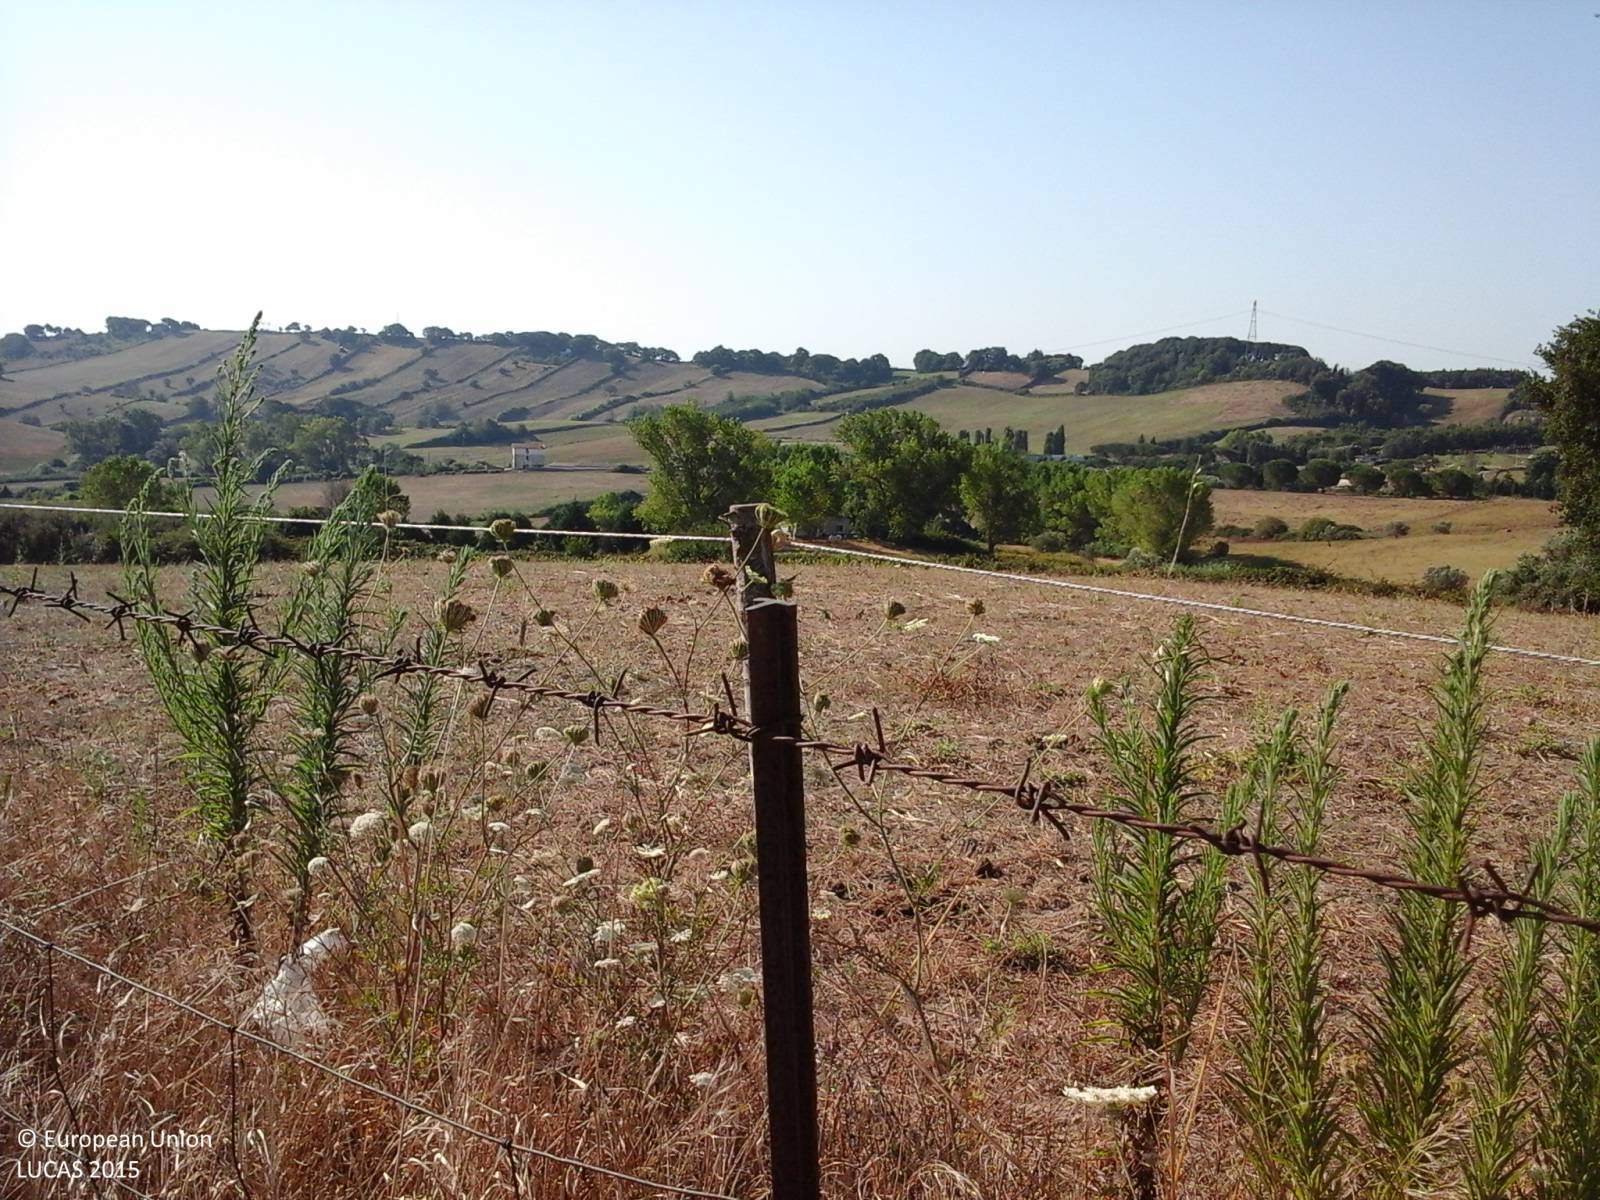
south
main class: Grassland
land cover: Grassland without tree/shrub cover
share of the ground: > 75 %
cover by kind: herbaceous plants 100 %
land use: Agriculture (excluding fallow land and kitchen gardens)
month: August
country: IT
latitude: 42.1027
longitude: 12.3495
